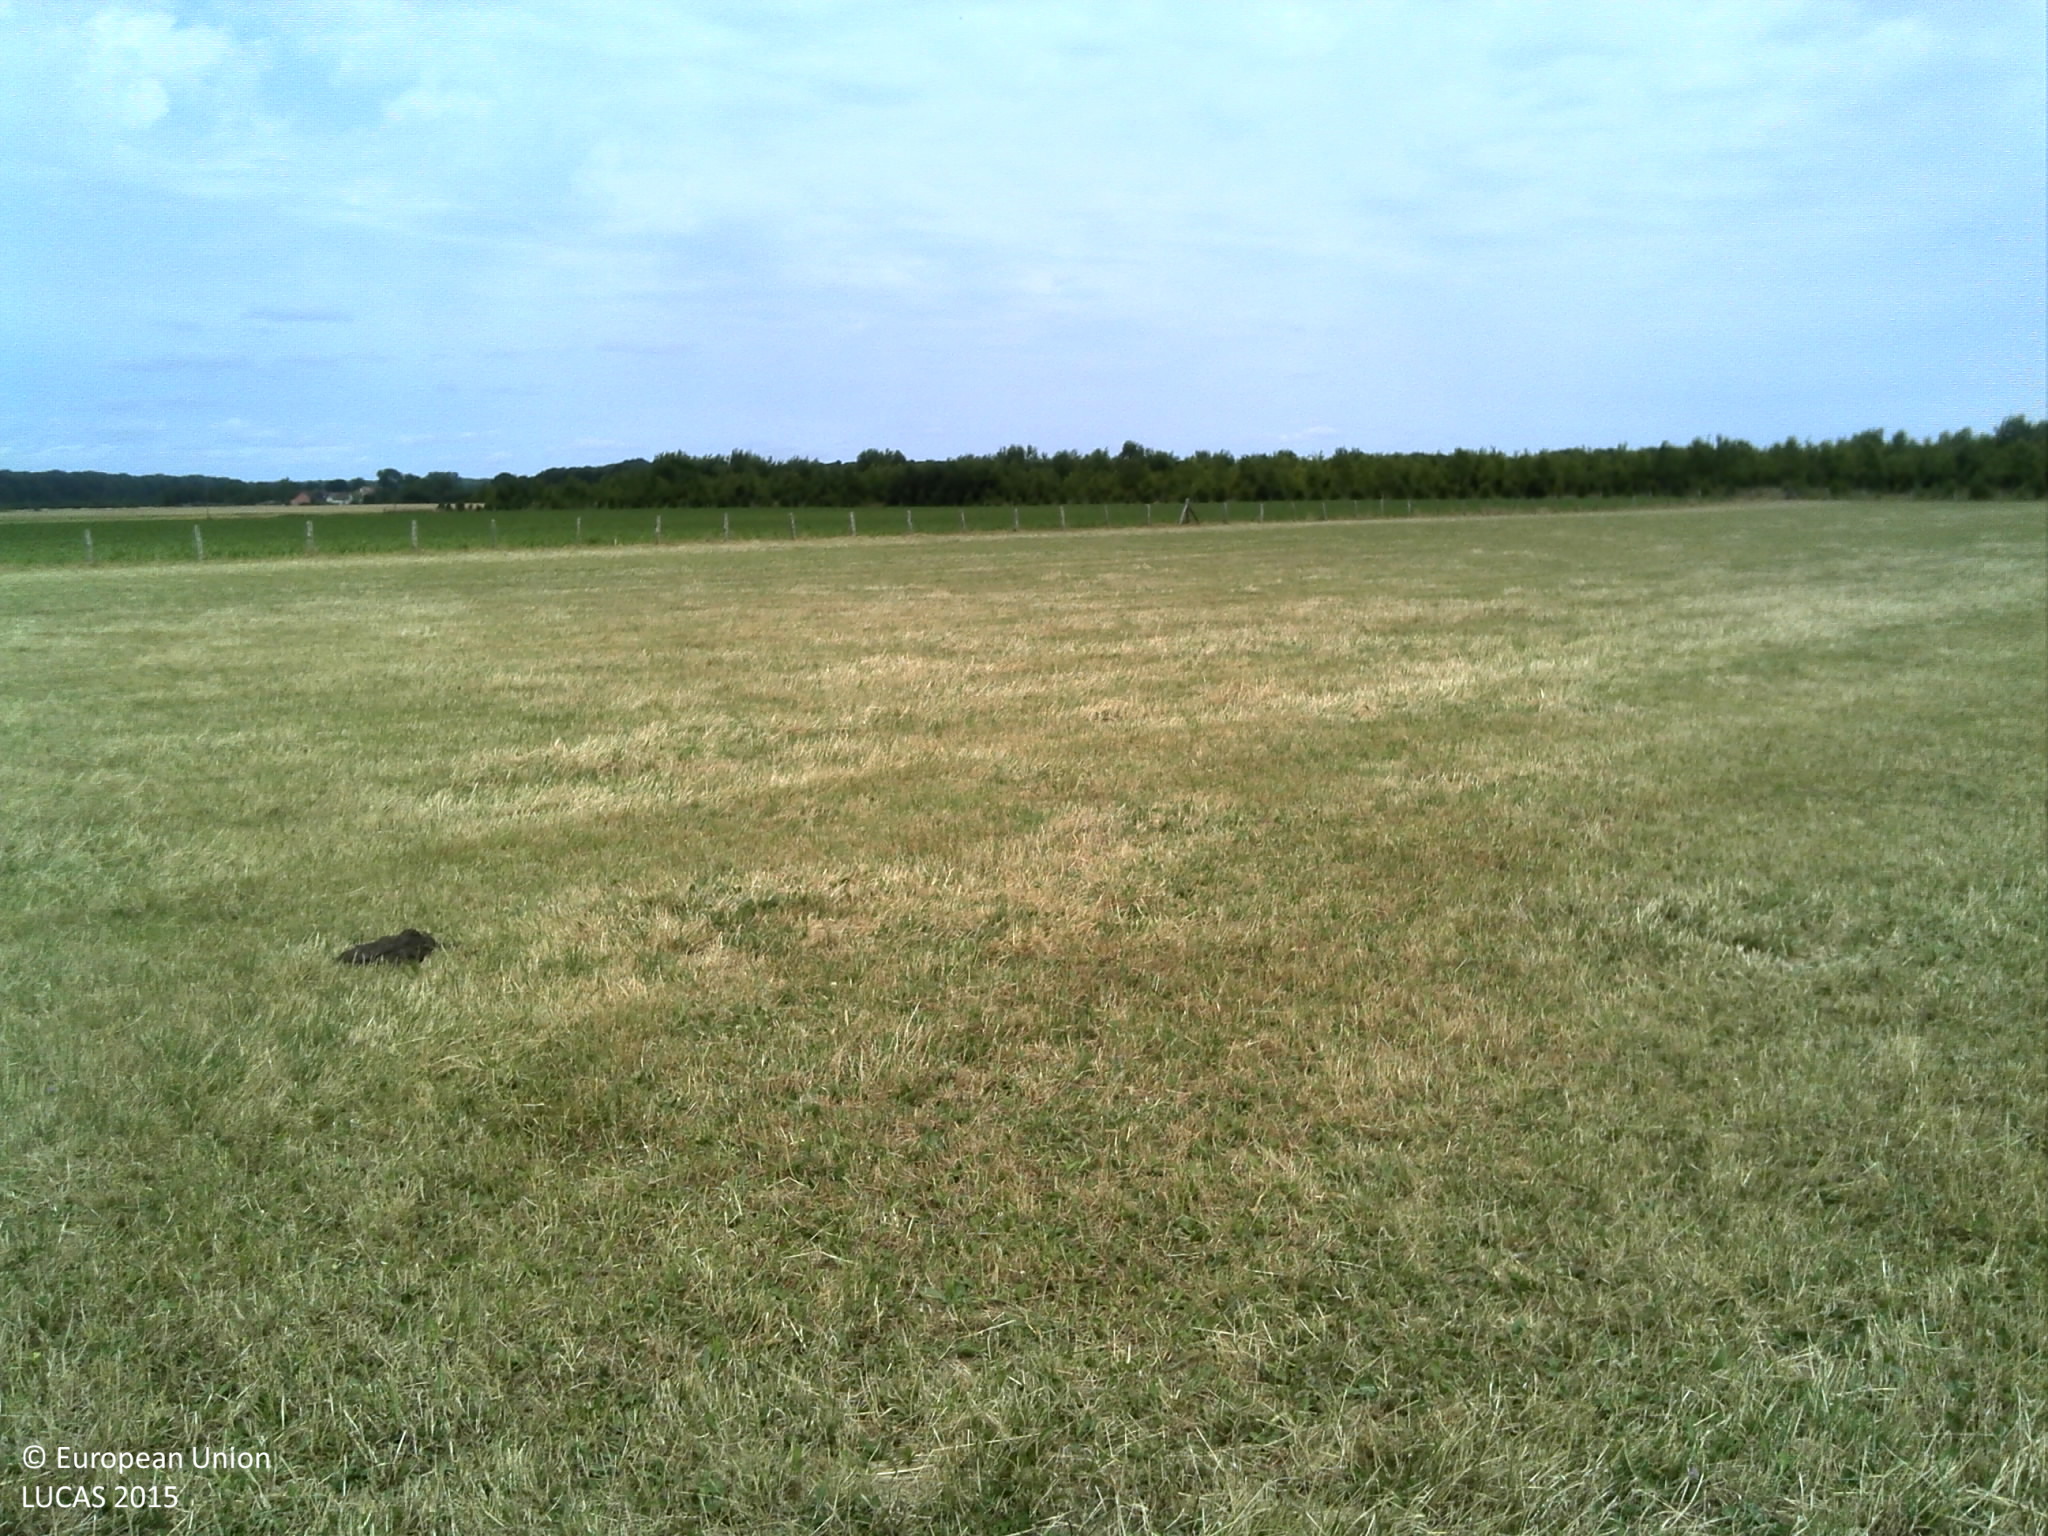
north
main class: Grassland
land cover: Grassland without tree/shrub cover
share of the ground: > 75 %
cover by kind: herbaceous plants 100 %
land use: Agriculture (excluding fallow land and kitchen gardens)
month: July
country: FR
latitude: 49.8575
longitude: 1.6222
